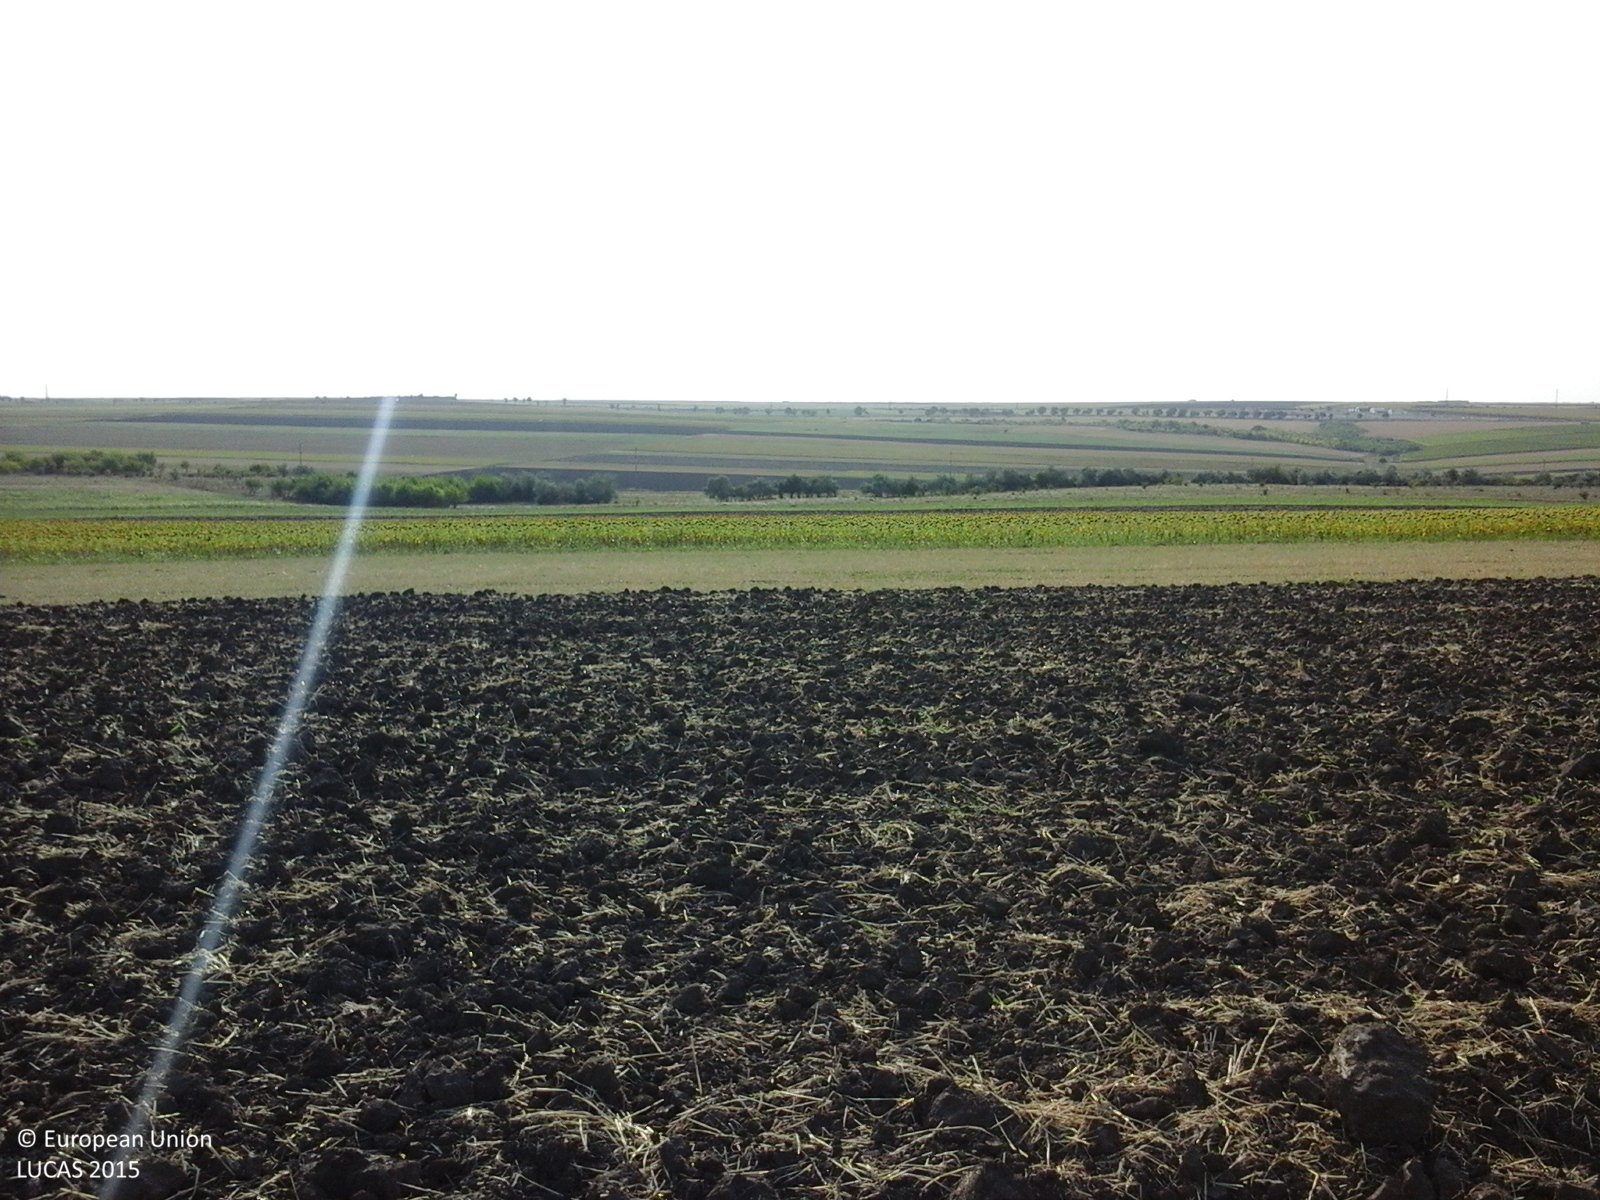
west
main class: Cropland
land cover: Barley
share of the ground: < 10 %
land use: Agriculture (excluding fallow land and kitchen gardens)
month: August
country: RO
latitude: 44.1321
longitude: 28.3758
